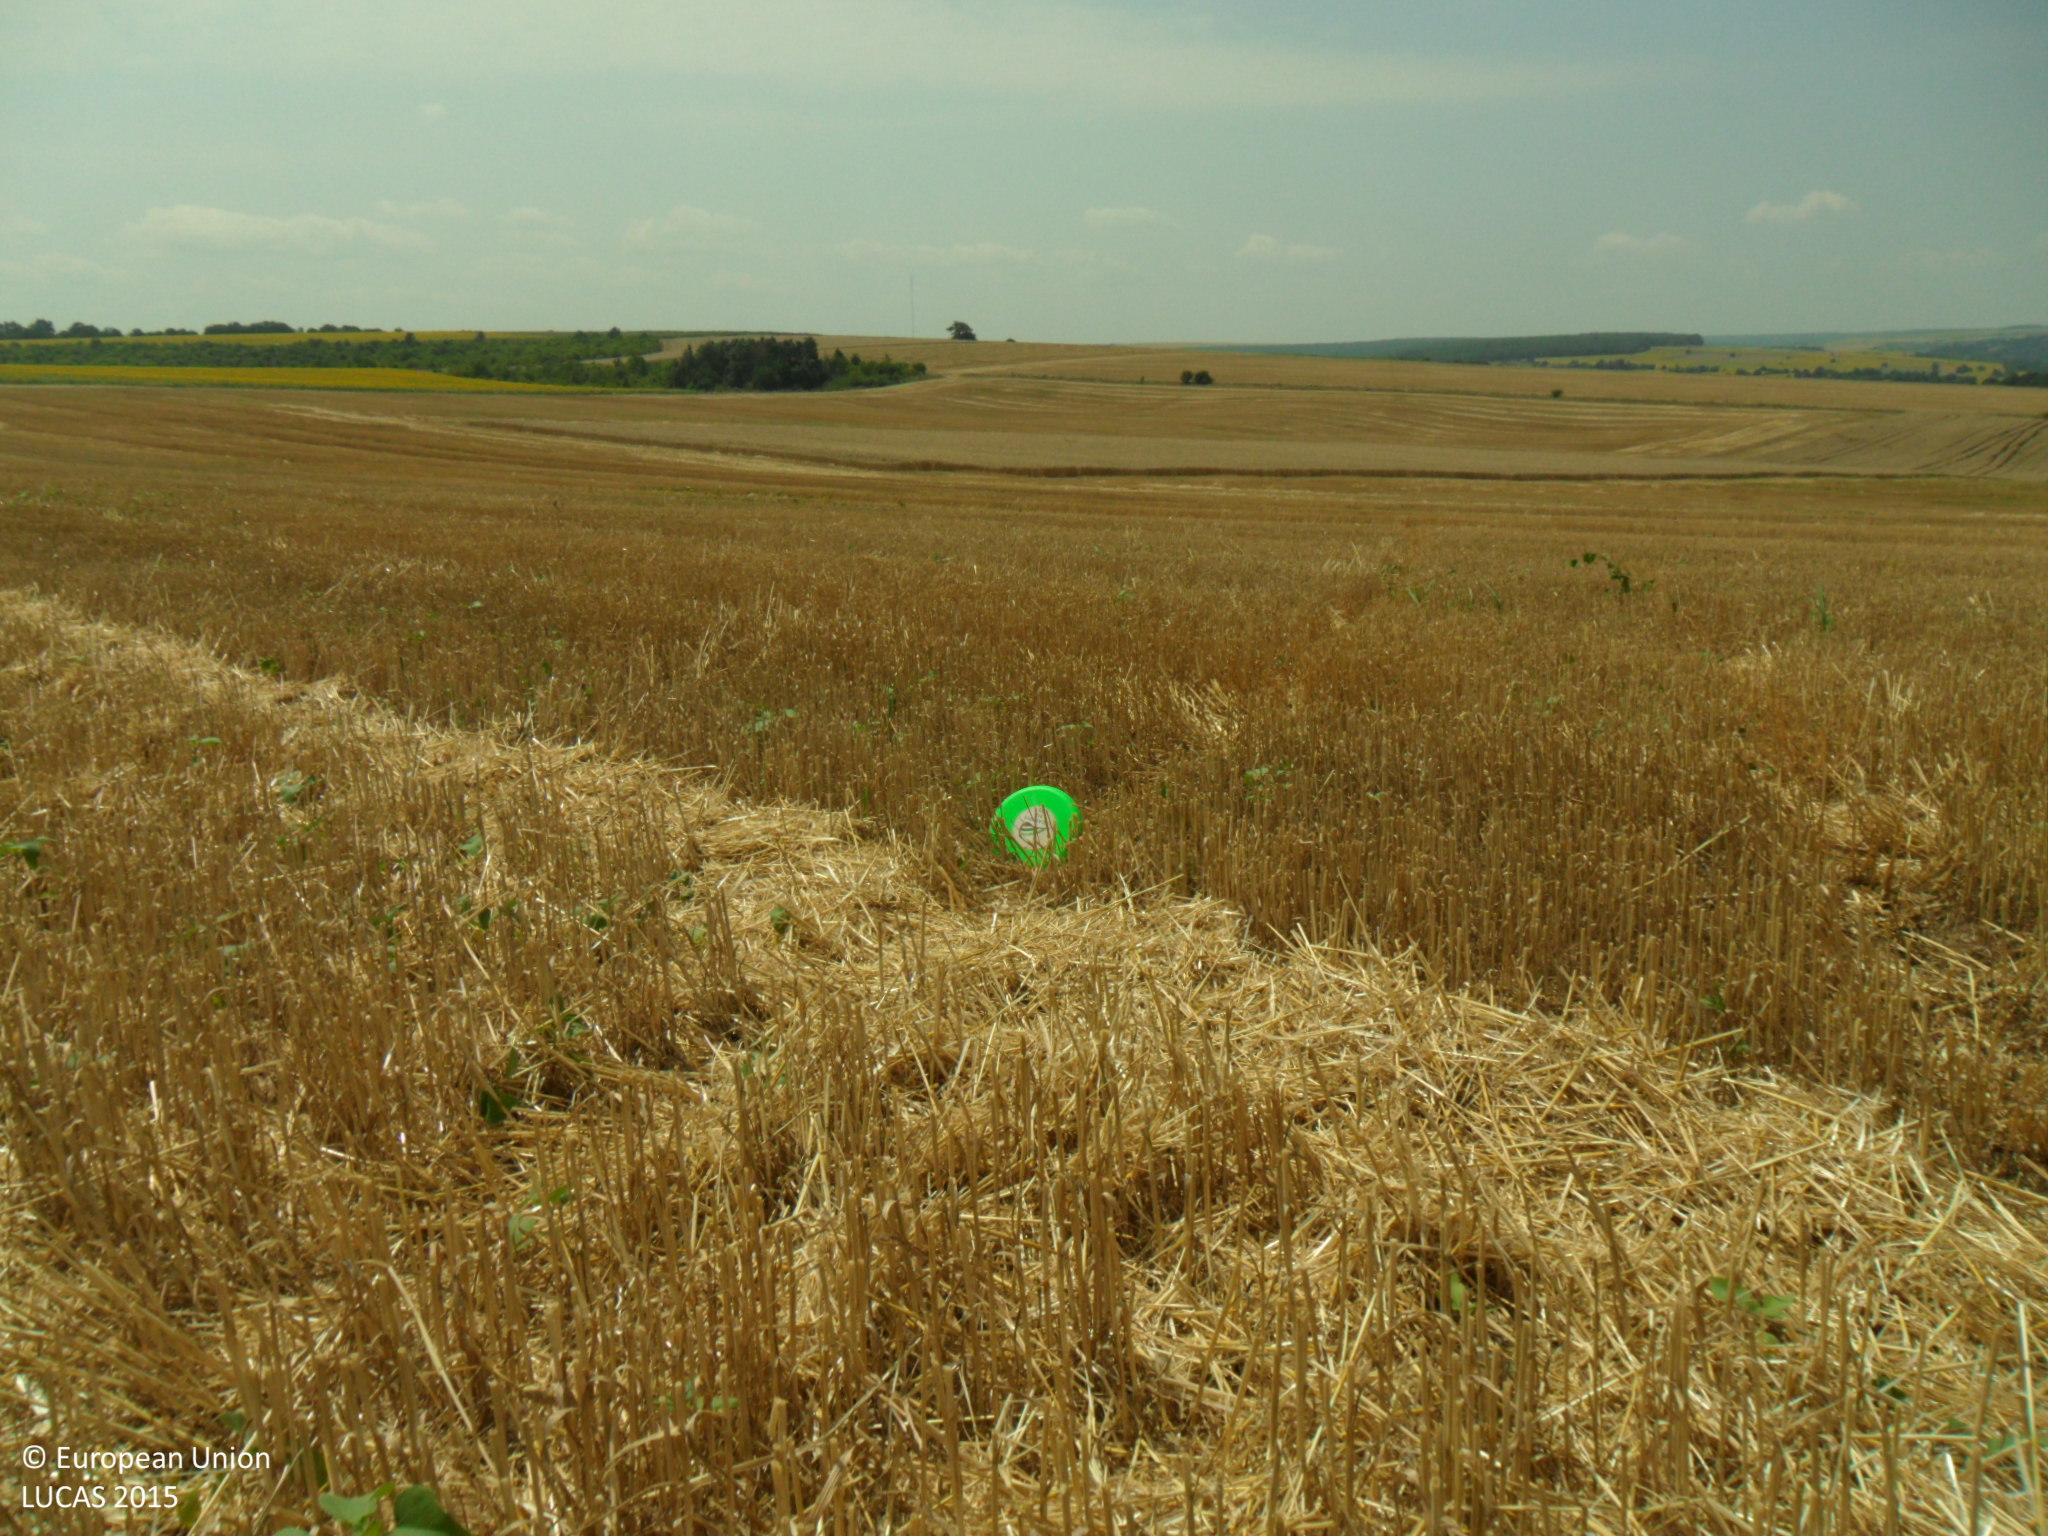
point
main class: Cropland
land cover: Common wheat
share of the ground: 25 - 50 %
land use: Agriculture (excluding fallow land and kitchen gardens)
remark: Harvested field
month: July
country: BG
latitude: 43.5528
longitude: 26.9385
